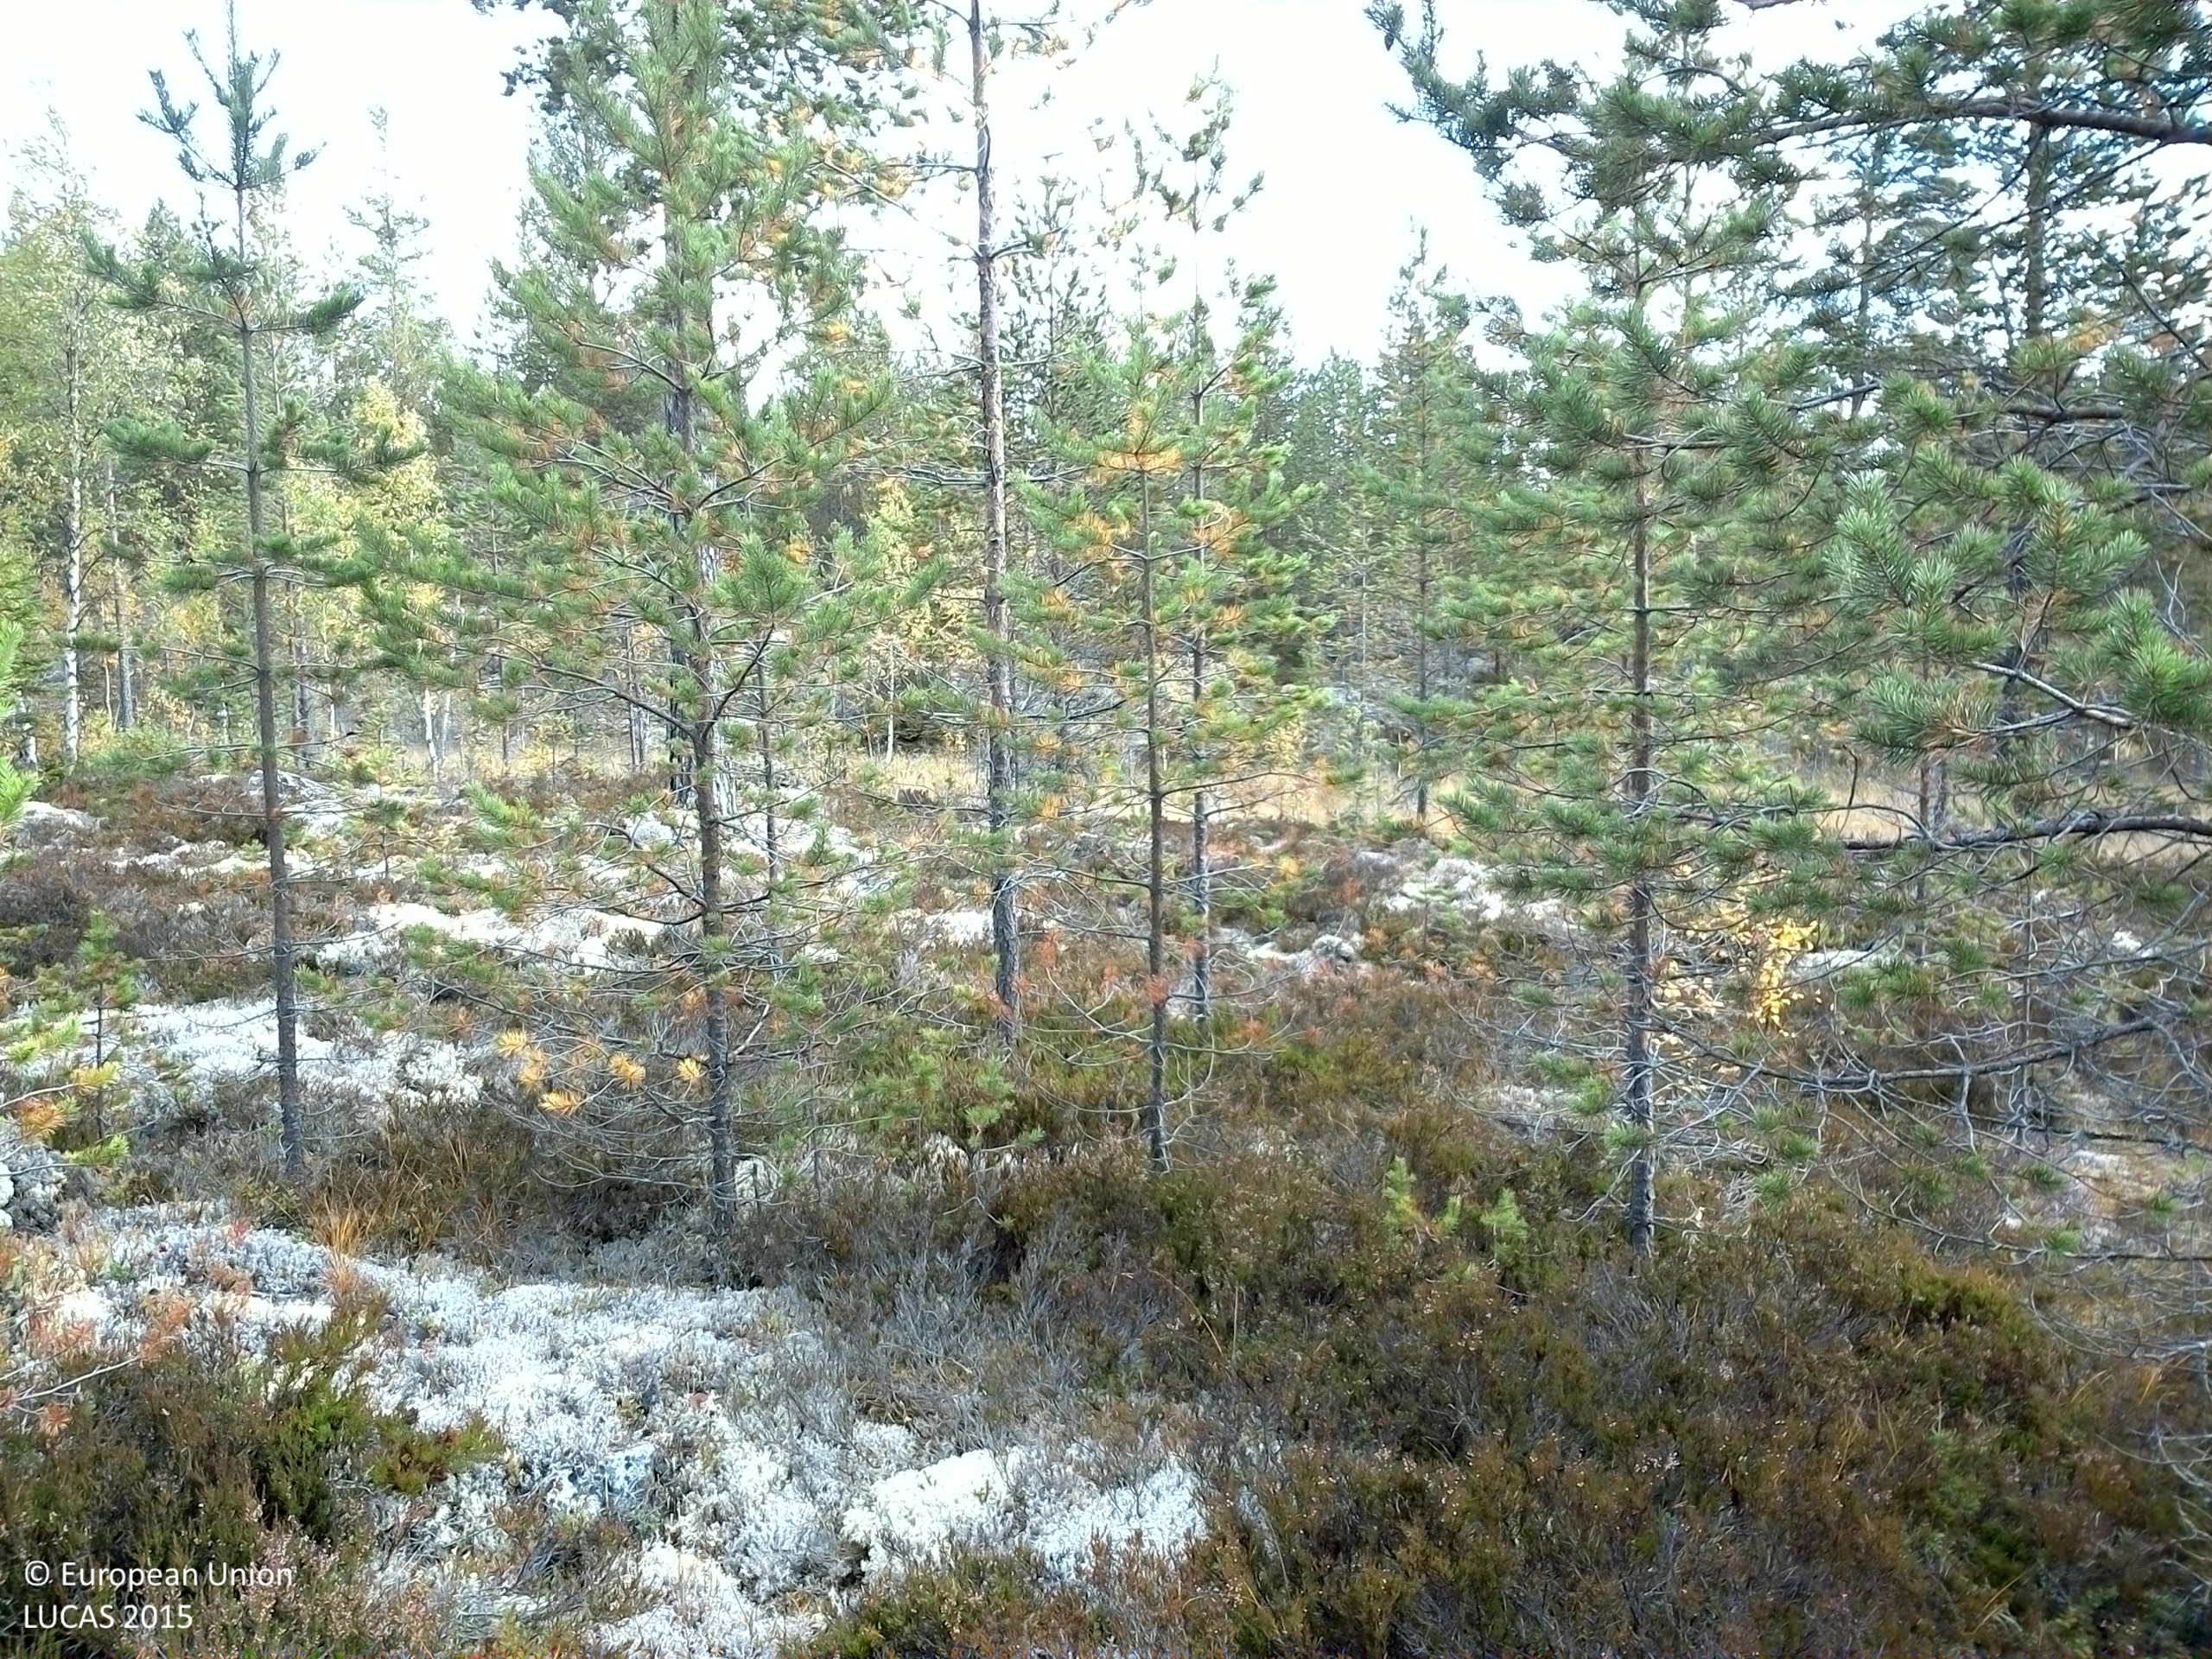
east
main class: Woodland
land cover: Pine dominated coniferous woodland
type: boreal forest
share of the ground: 10 - 25 %
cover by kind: lichens and mosses 35 %, shrubs 30 %, coniferous forest trees 15 %, herbaceous plants 15 %, broadleaved forest trees 5 %
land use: Forestry
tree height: < 5 m
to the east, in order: Pine dominated coniferous woodland; Inland marshes; Pine dominated coniferous woodland; Inland fresh running water; Pine dominated mixed woodland; Paved roads, cycling and walking lanes; Pine dominated coniferous woodland
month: September
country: SE
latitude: 61.5934
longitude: 14.9022
